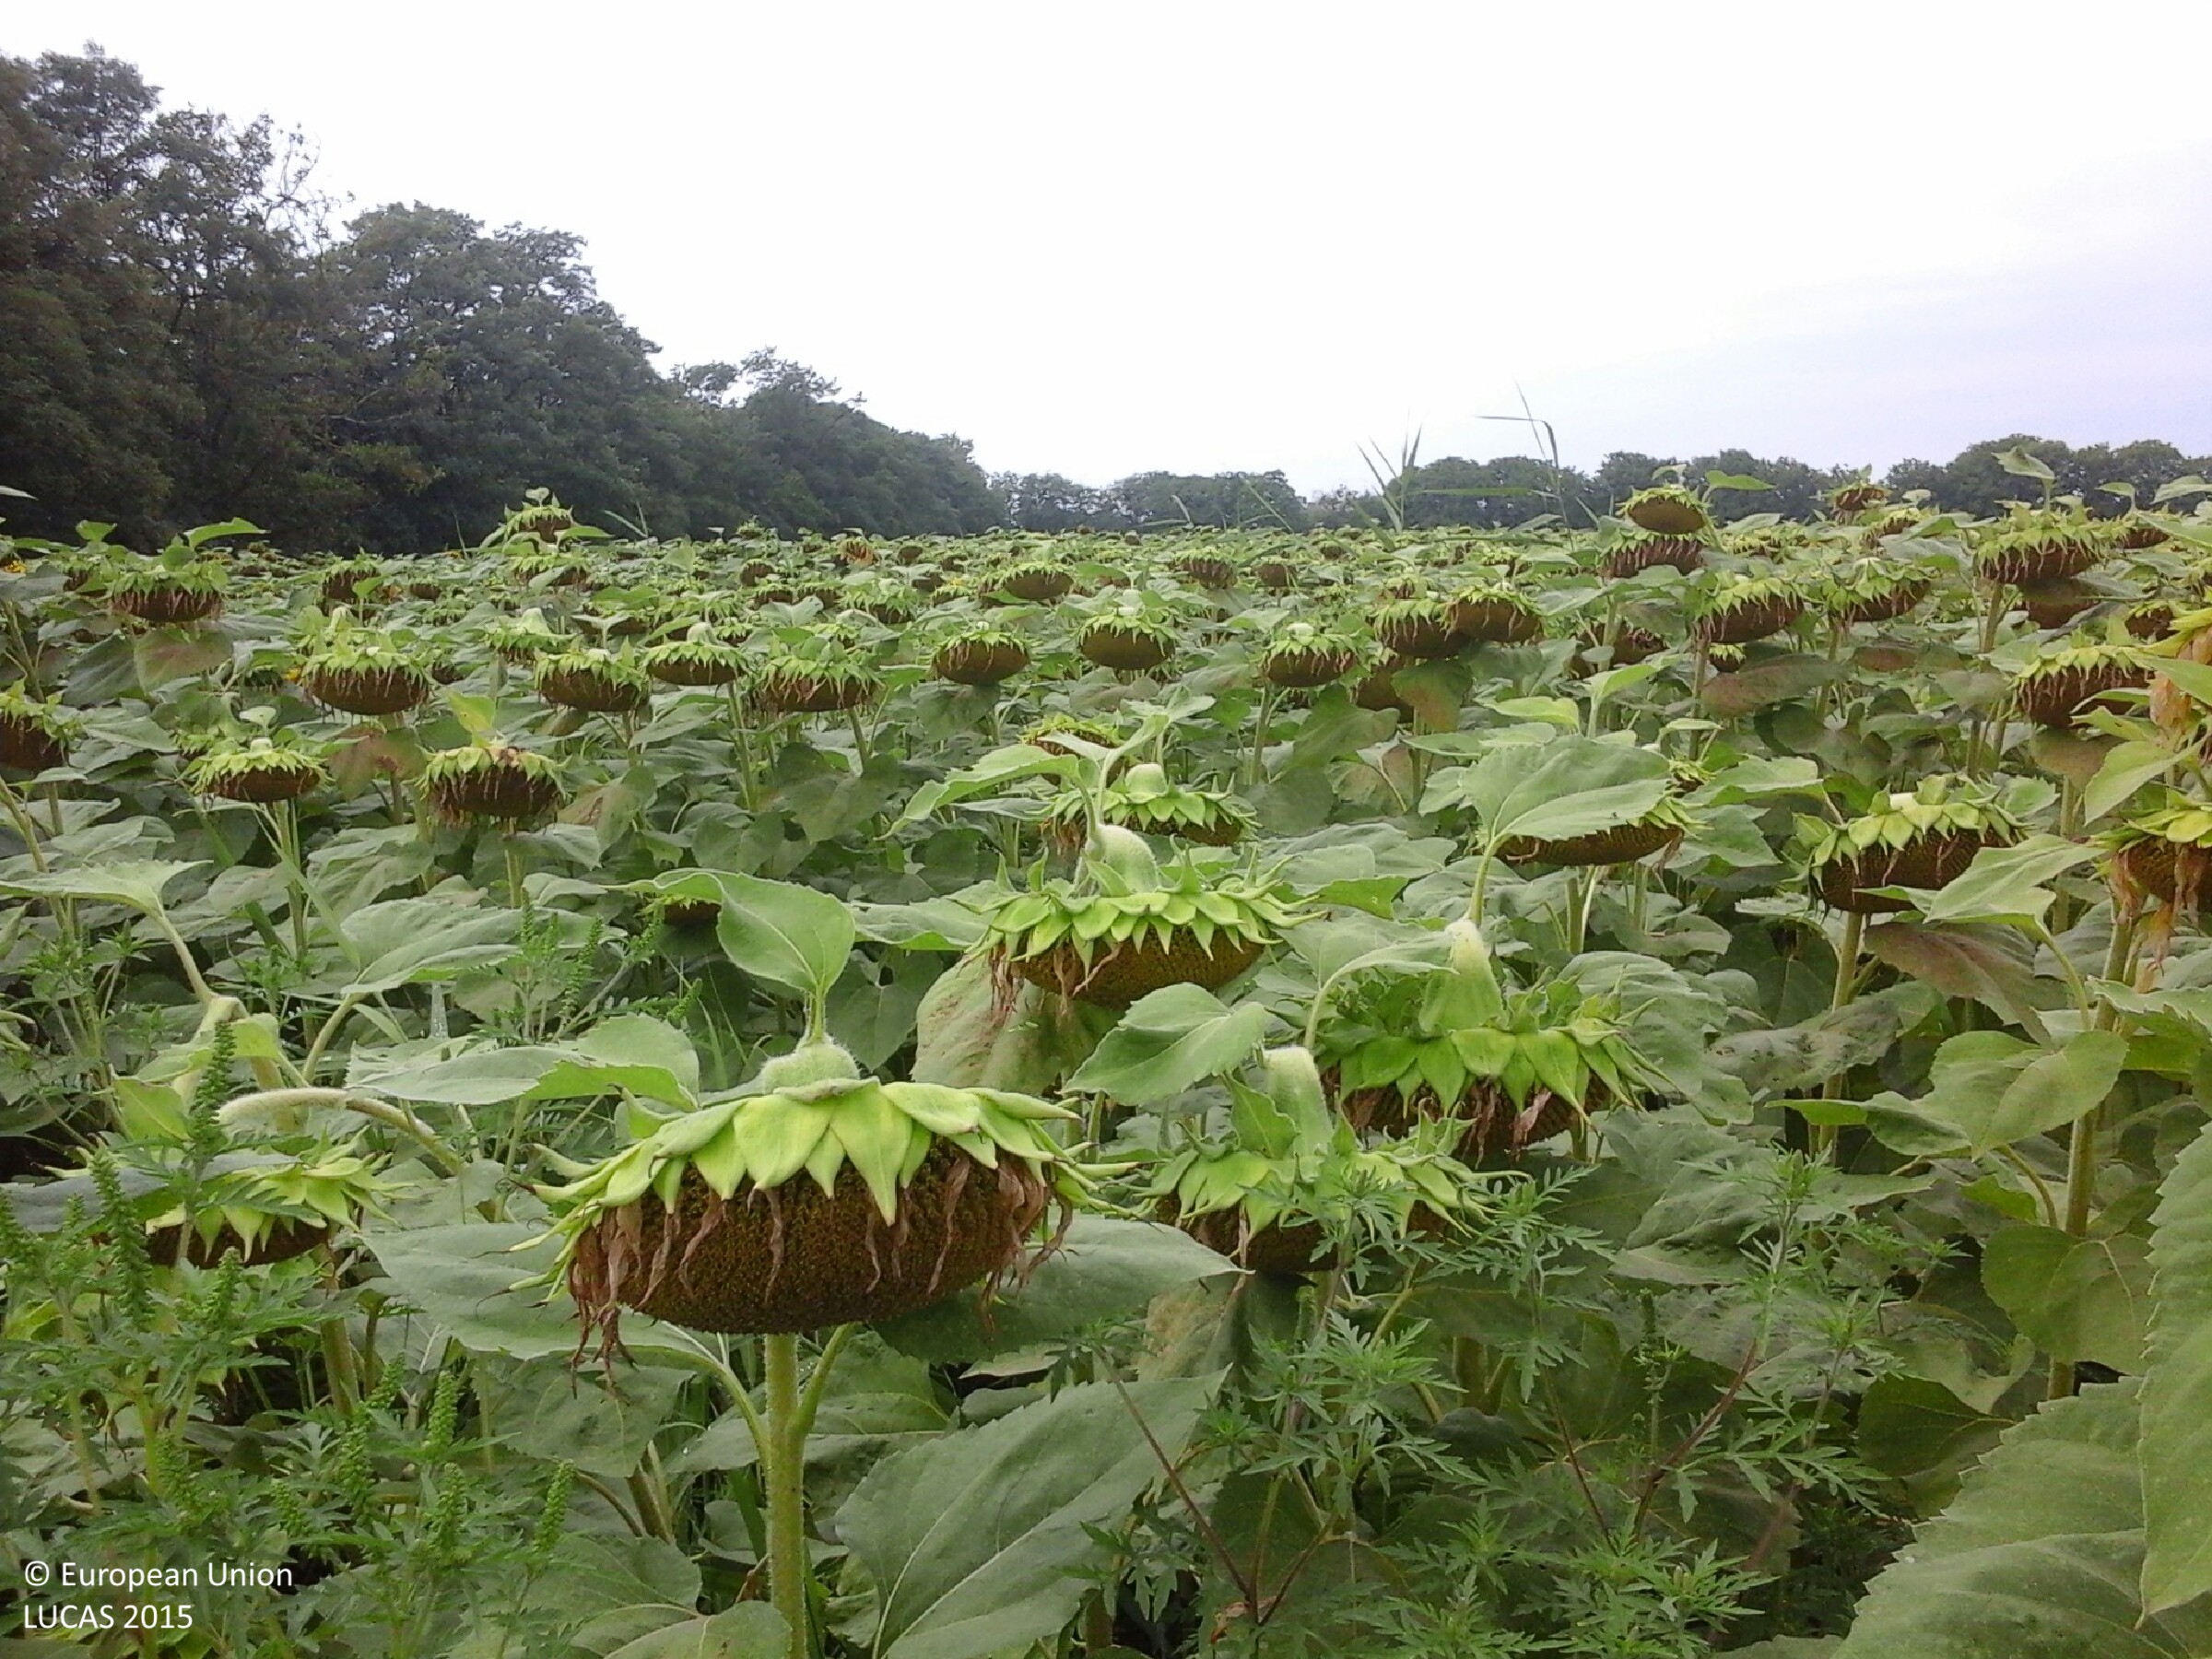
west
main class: Cropland
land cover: Sunflower
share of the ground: > 75 %
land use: Agriculture (excluding fallow land and kitchen gardens)
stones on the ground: < 10 %
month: August
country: HU
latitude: 47.5655
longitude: 20.7875
